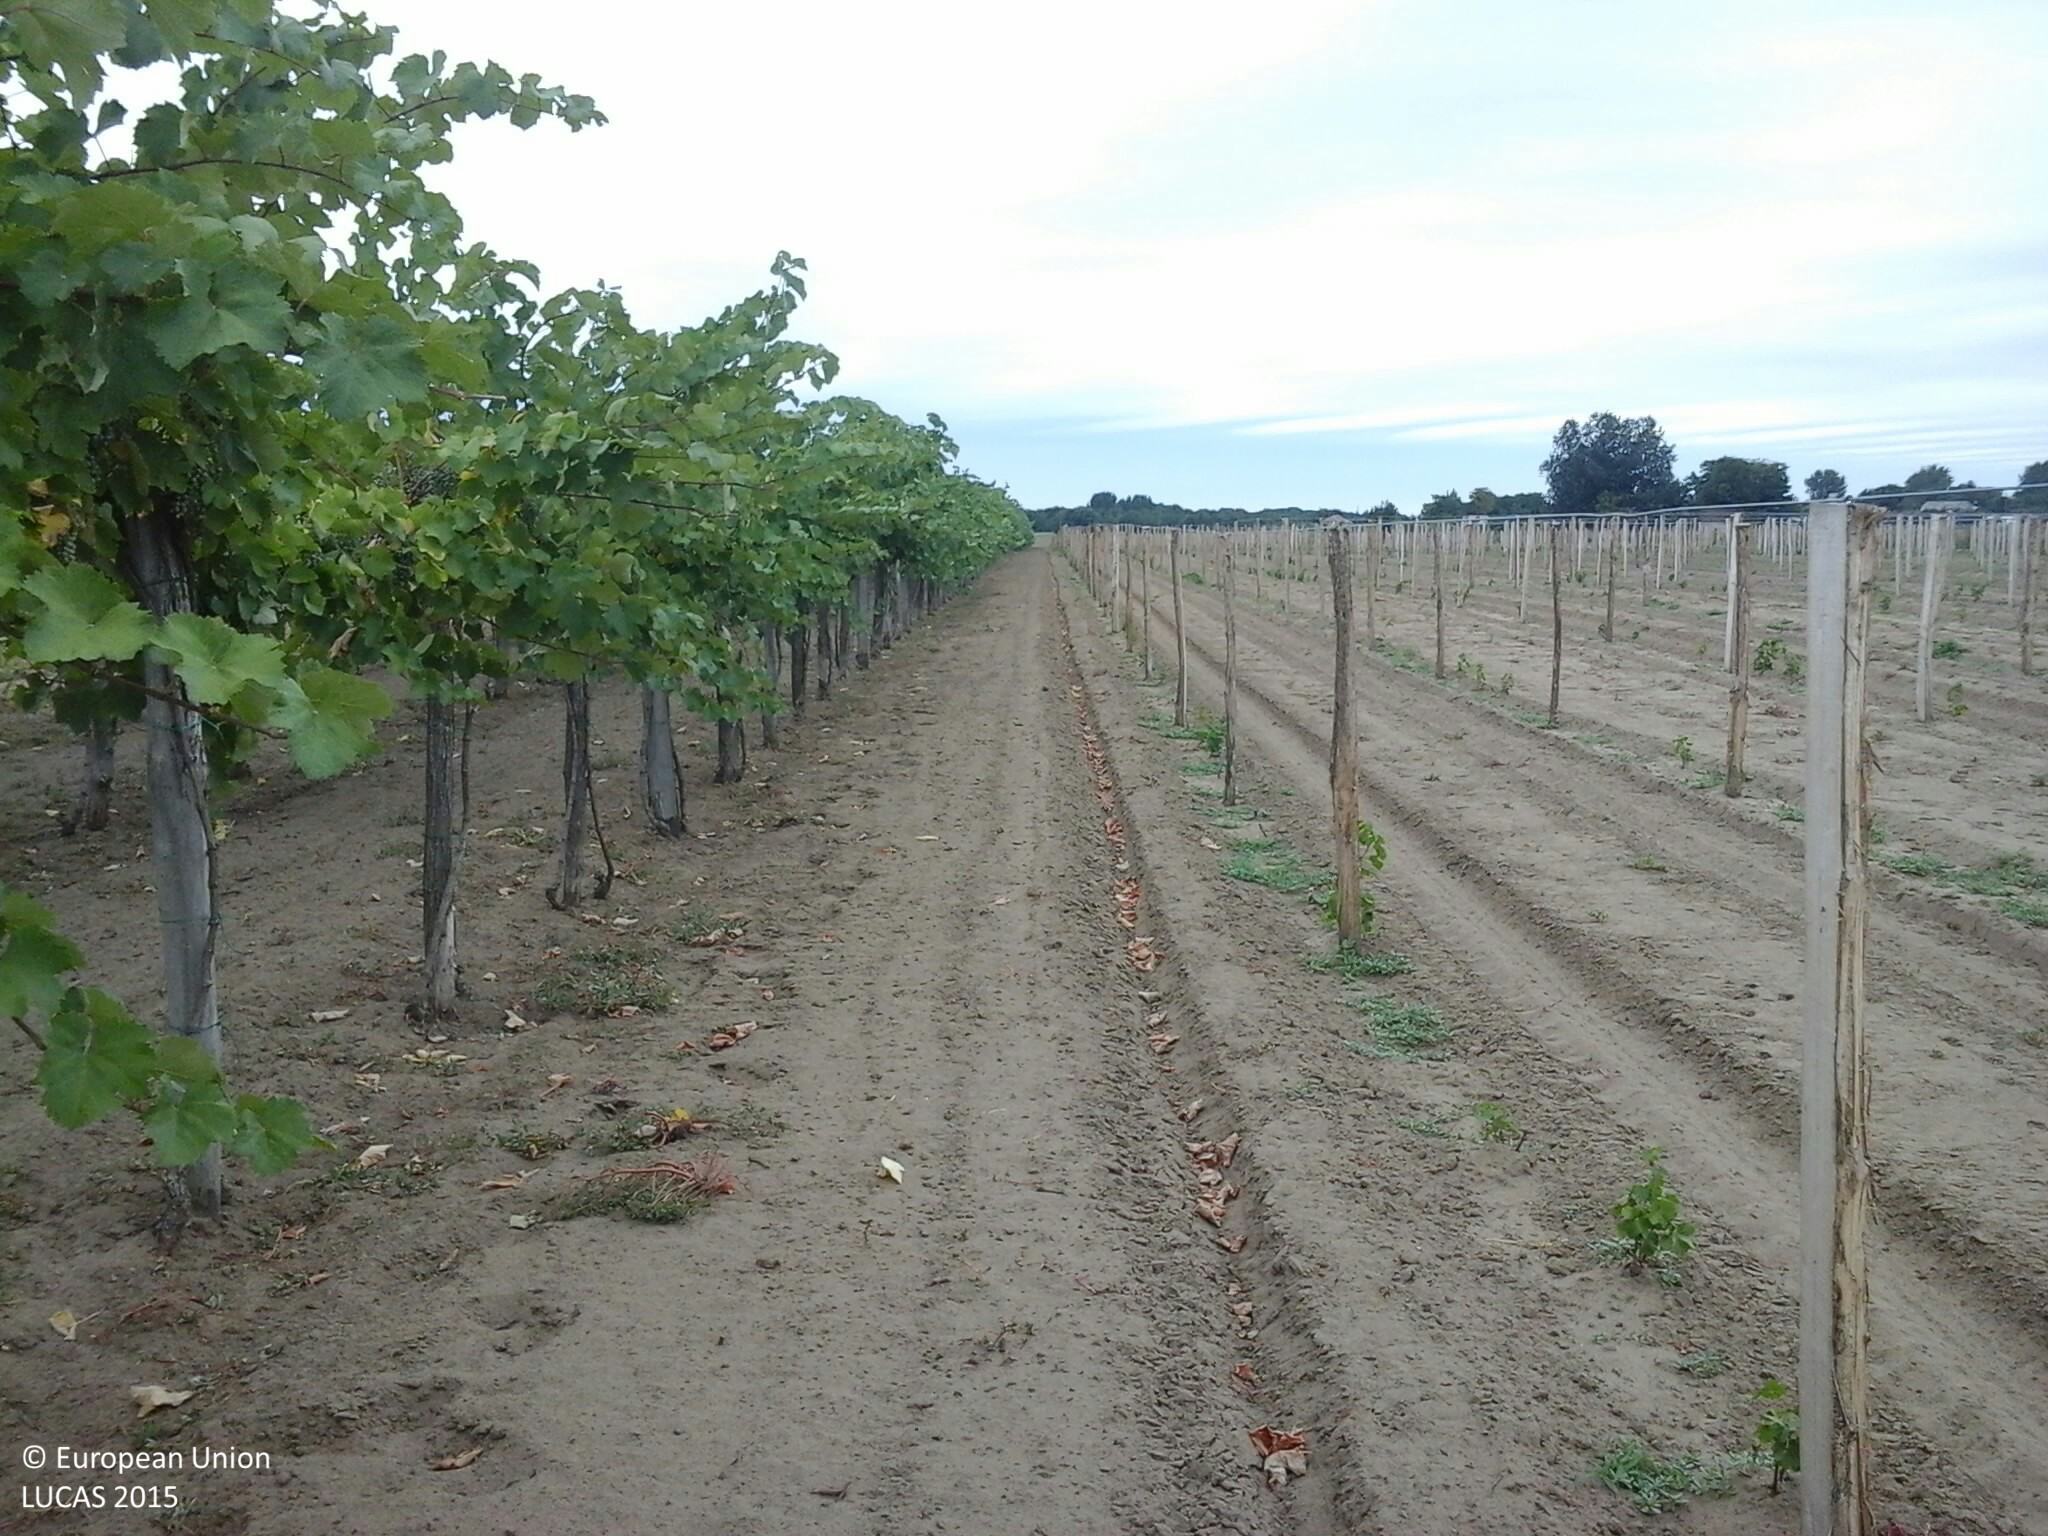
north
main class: Cropland
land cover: Vineyards
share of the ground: 25 - 50 %
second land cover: Other bare soil
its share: > 75 %
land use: Agriculture (excluding fallow land and kitchen gardens)
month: July
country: HU
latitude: 46.8484
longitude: 20.1355
